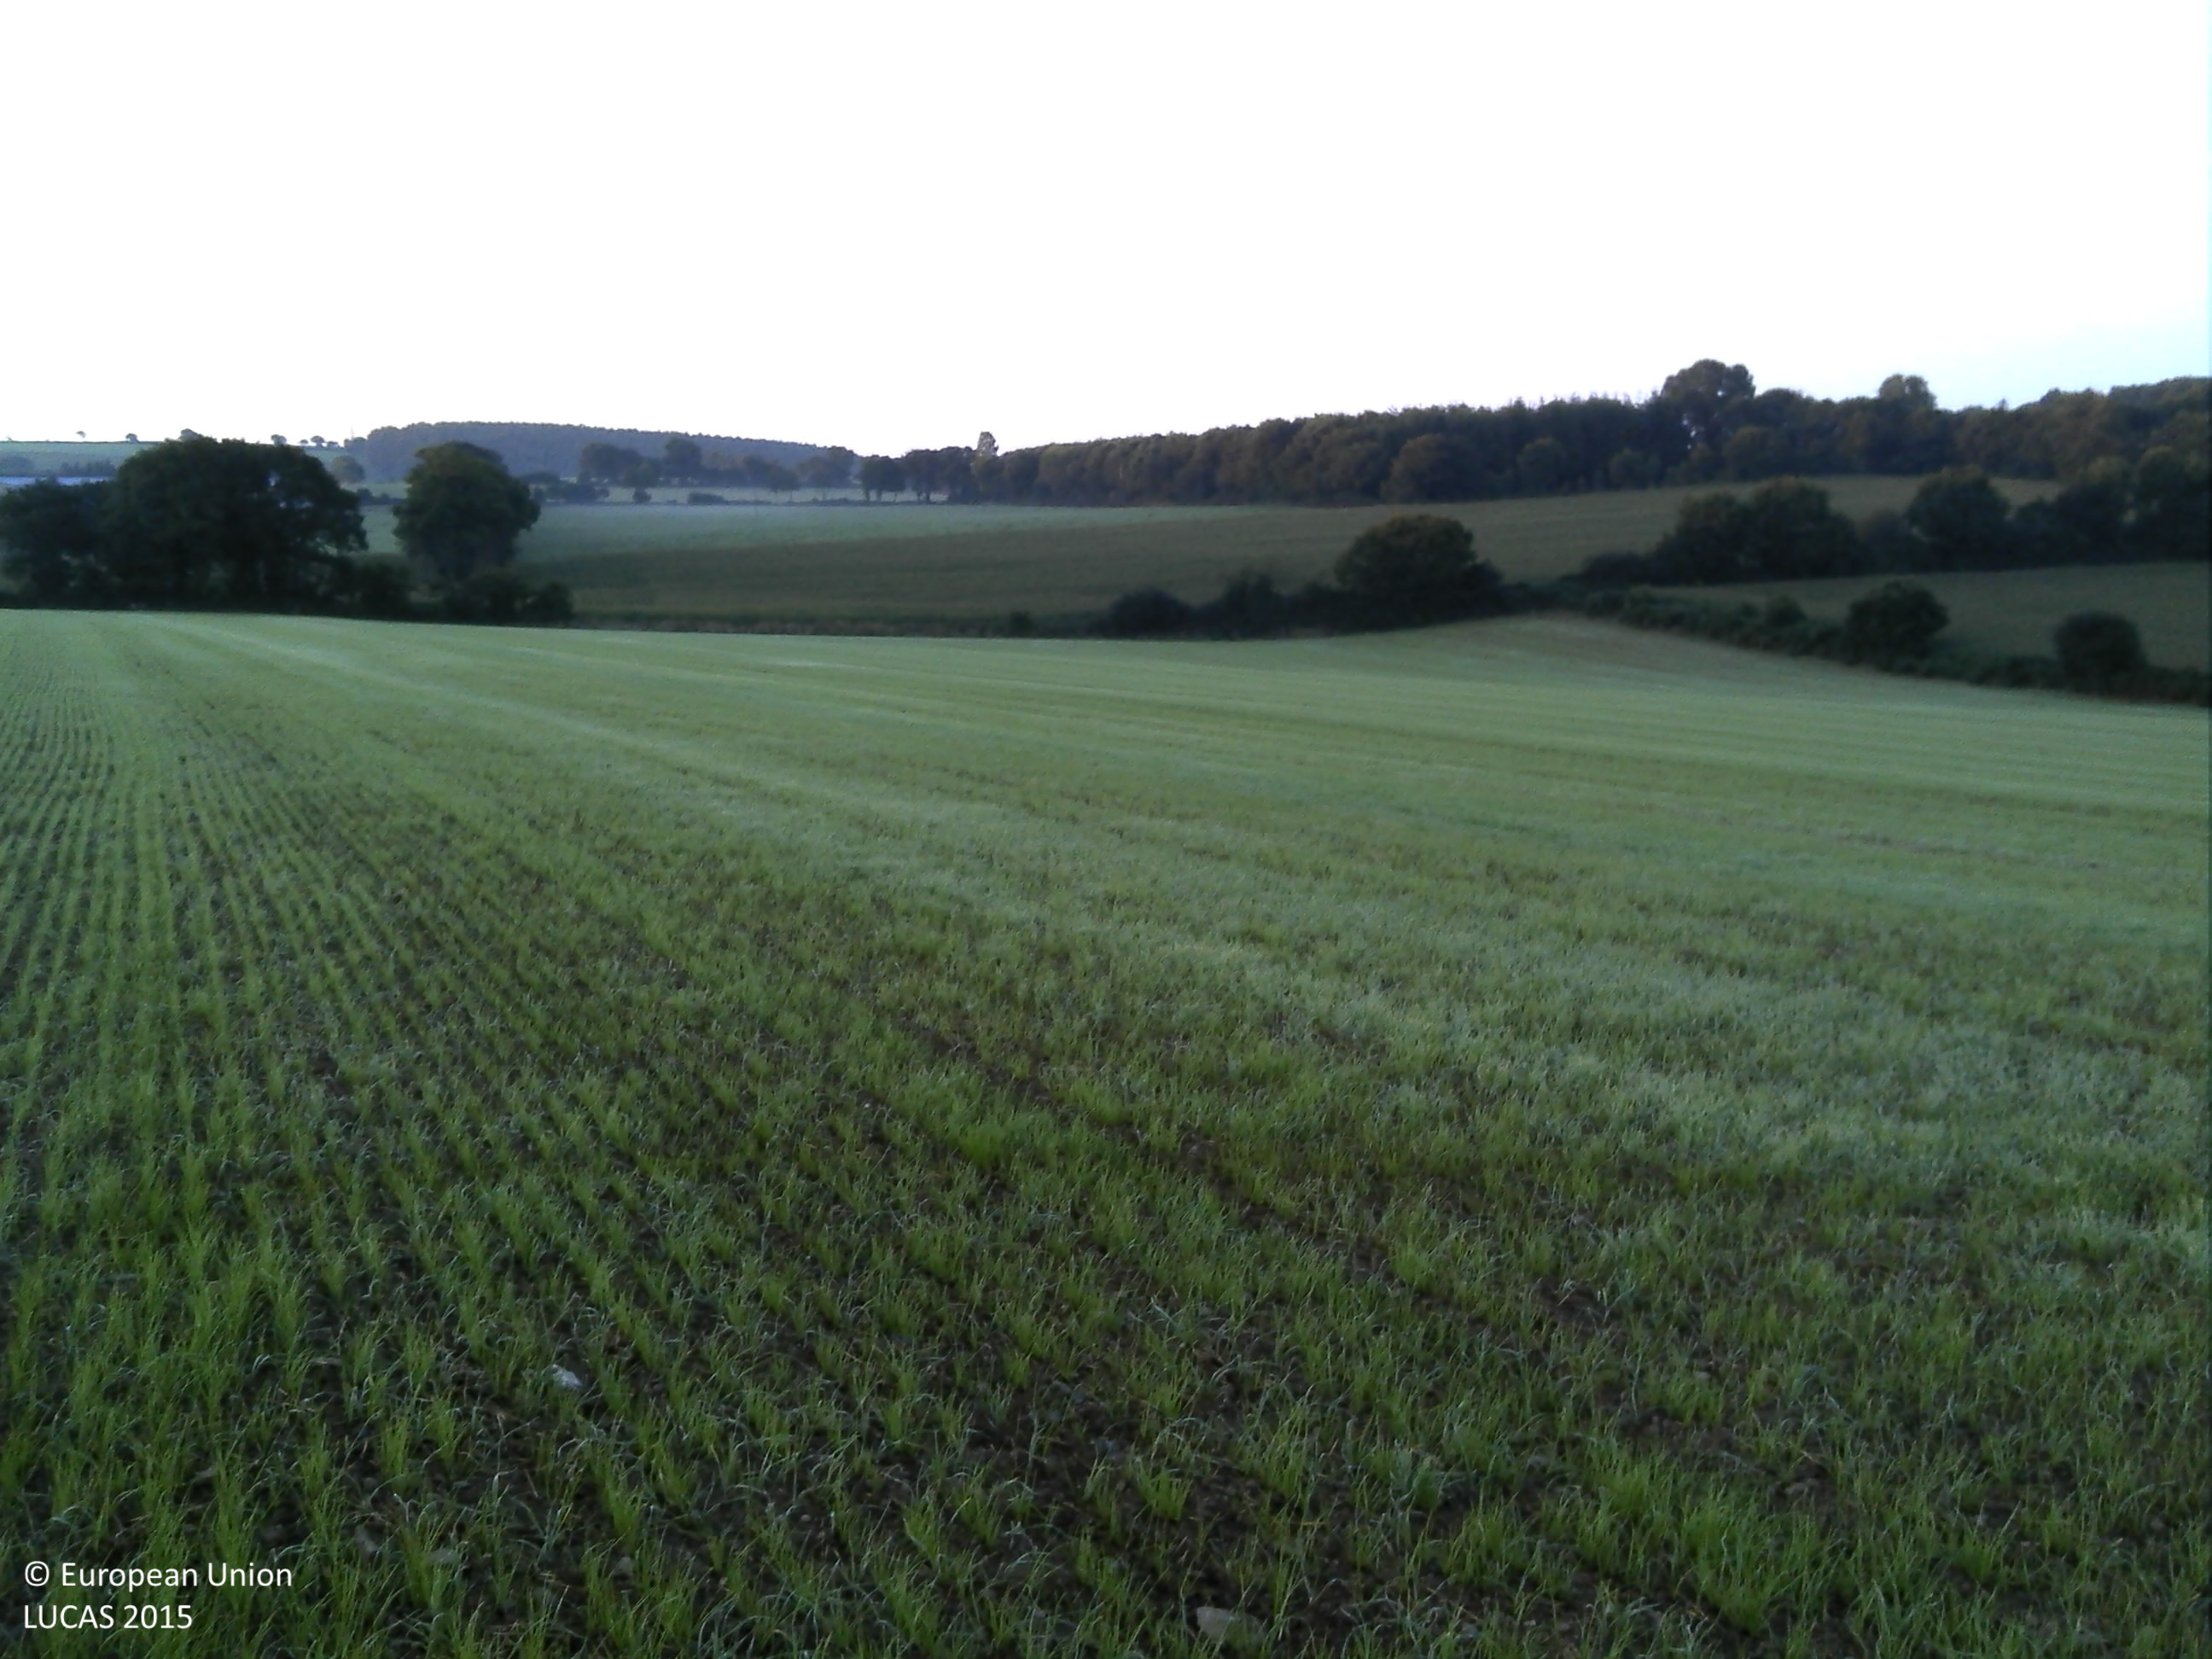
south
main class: Cropland
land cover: Temporary grasslands
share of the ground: 50 - 75 %
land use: Agriculture (excluding fallow land and kitchen gardens)
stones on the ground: 10 - 25 %
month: September
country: FR
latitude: 48.2575
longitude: -3.6994
